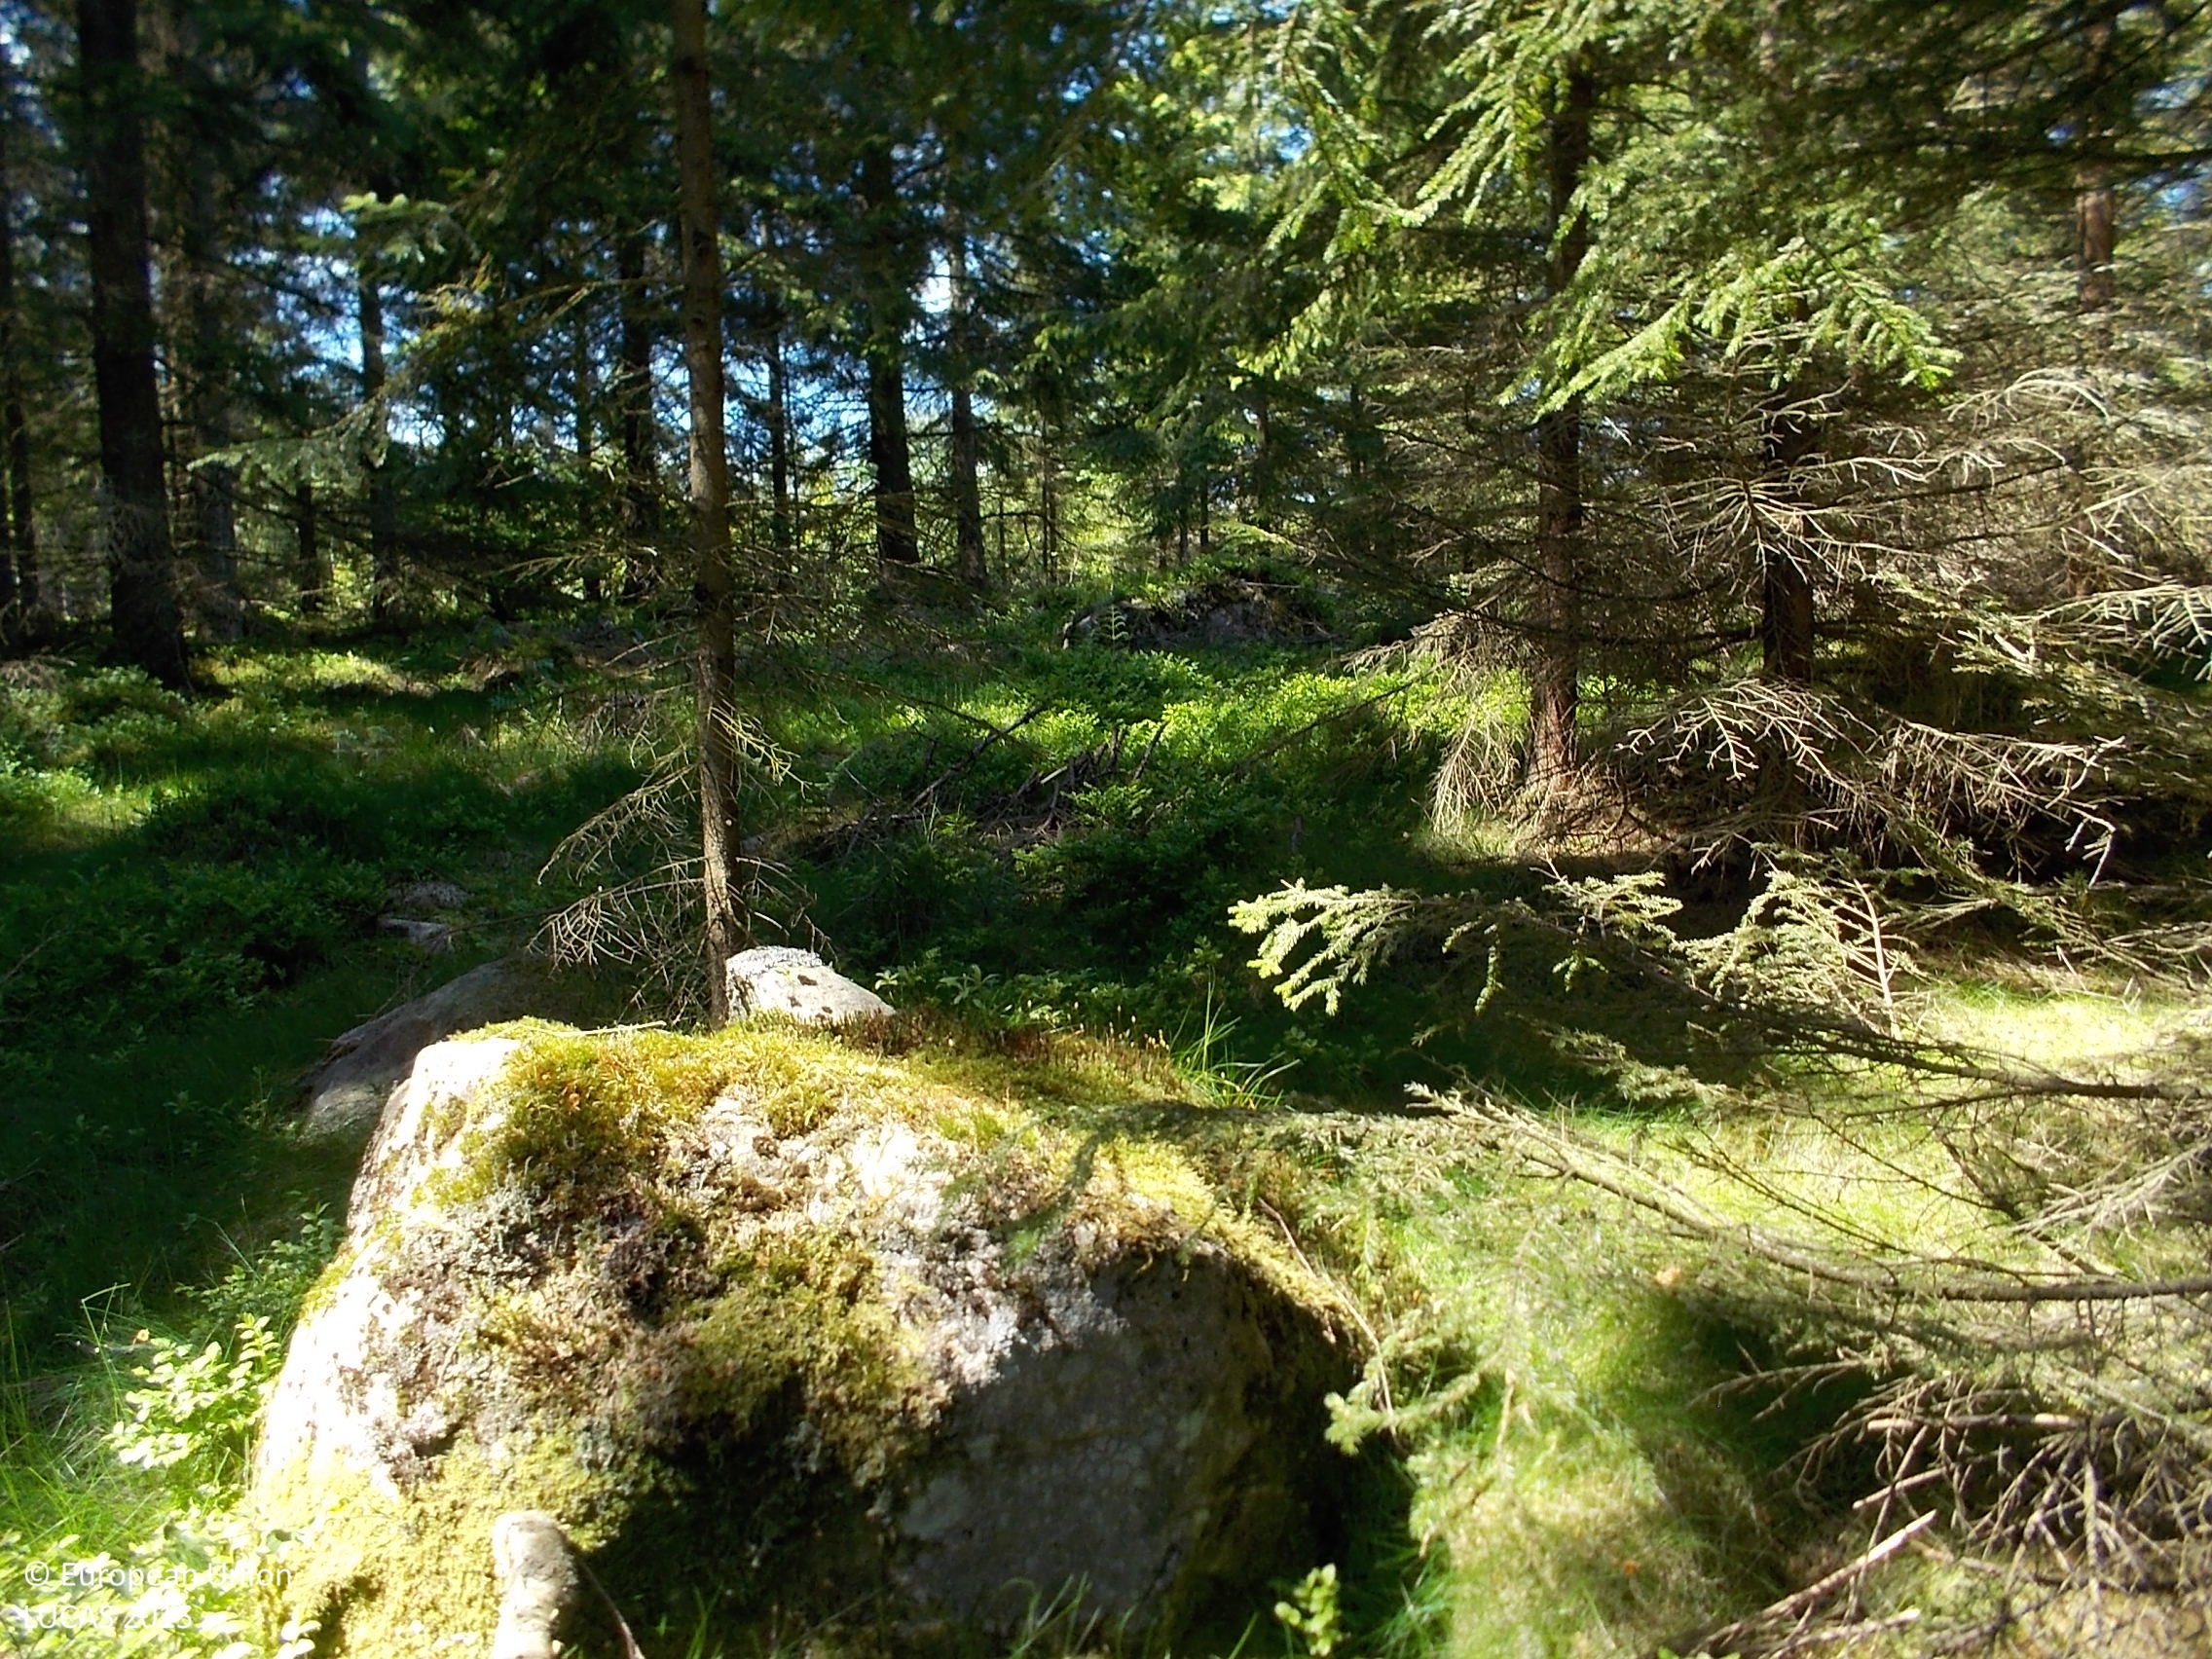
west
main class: Woodland
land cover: Spruce dominated coniferous woodland
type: boreal forest
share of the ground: > 75 %
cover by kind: coniferous forest trees 90 %, shrubs 5 %, lichens and mosses 5 %
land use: Forestry
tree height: > 5 m
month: June
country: SE
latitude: 57.7314
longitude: 13.2029
